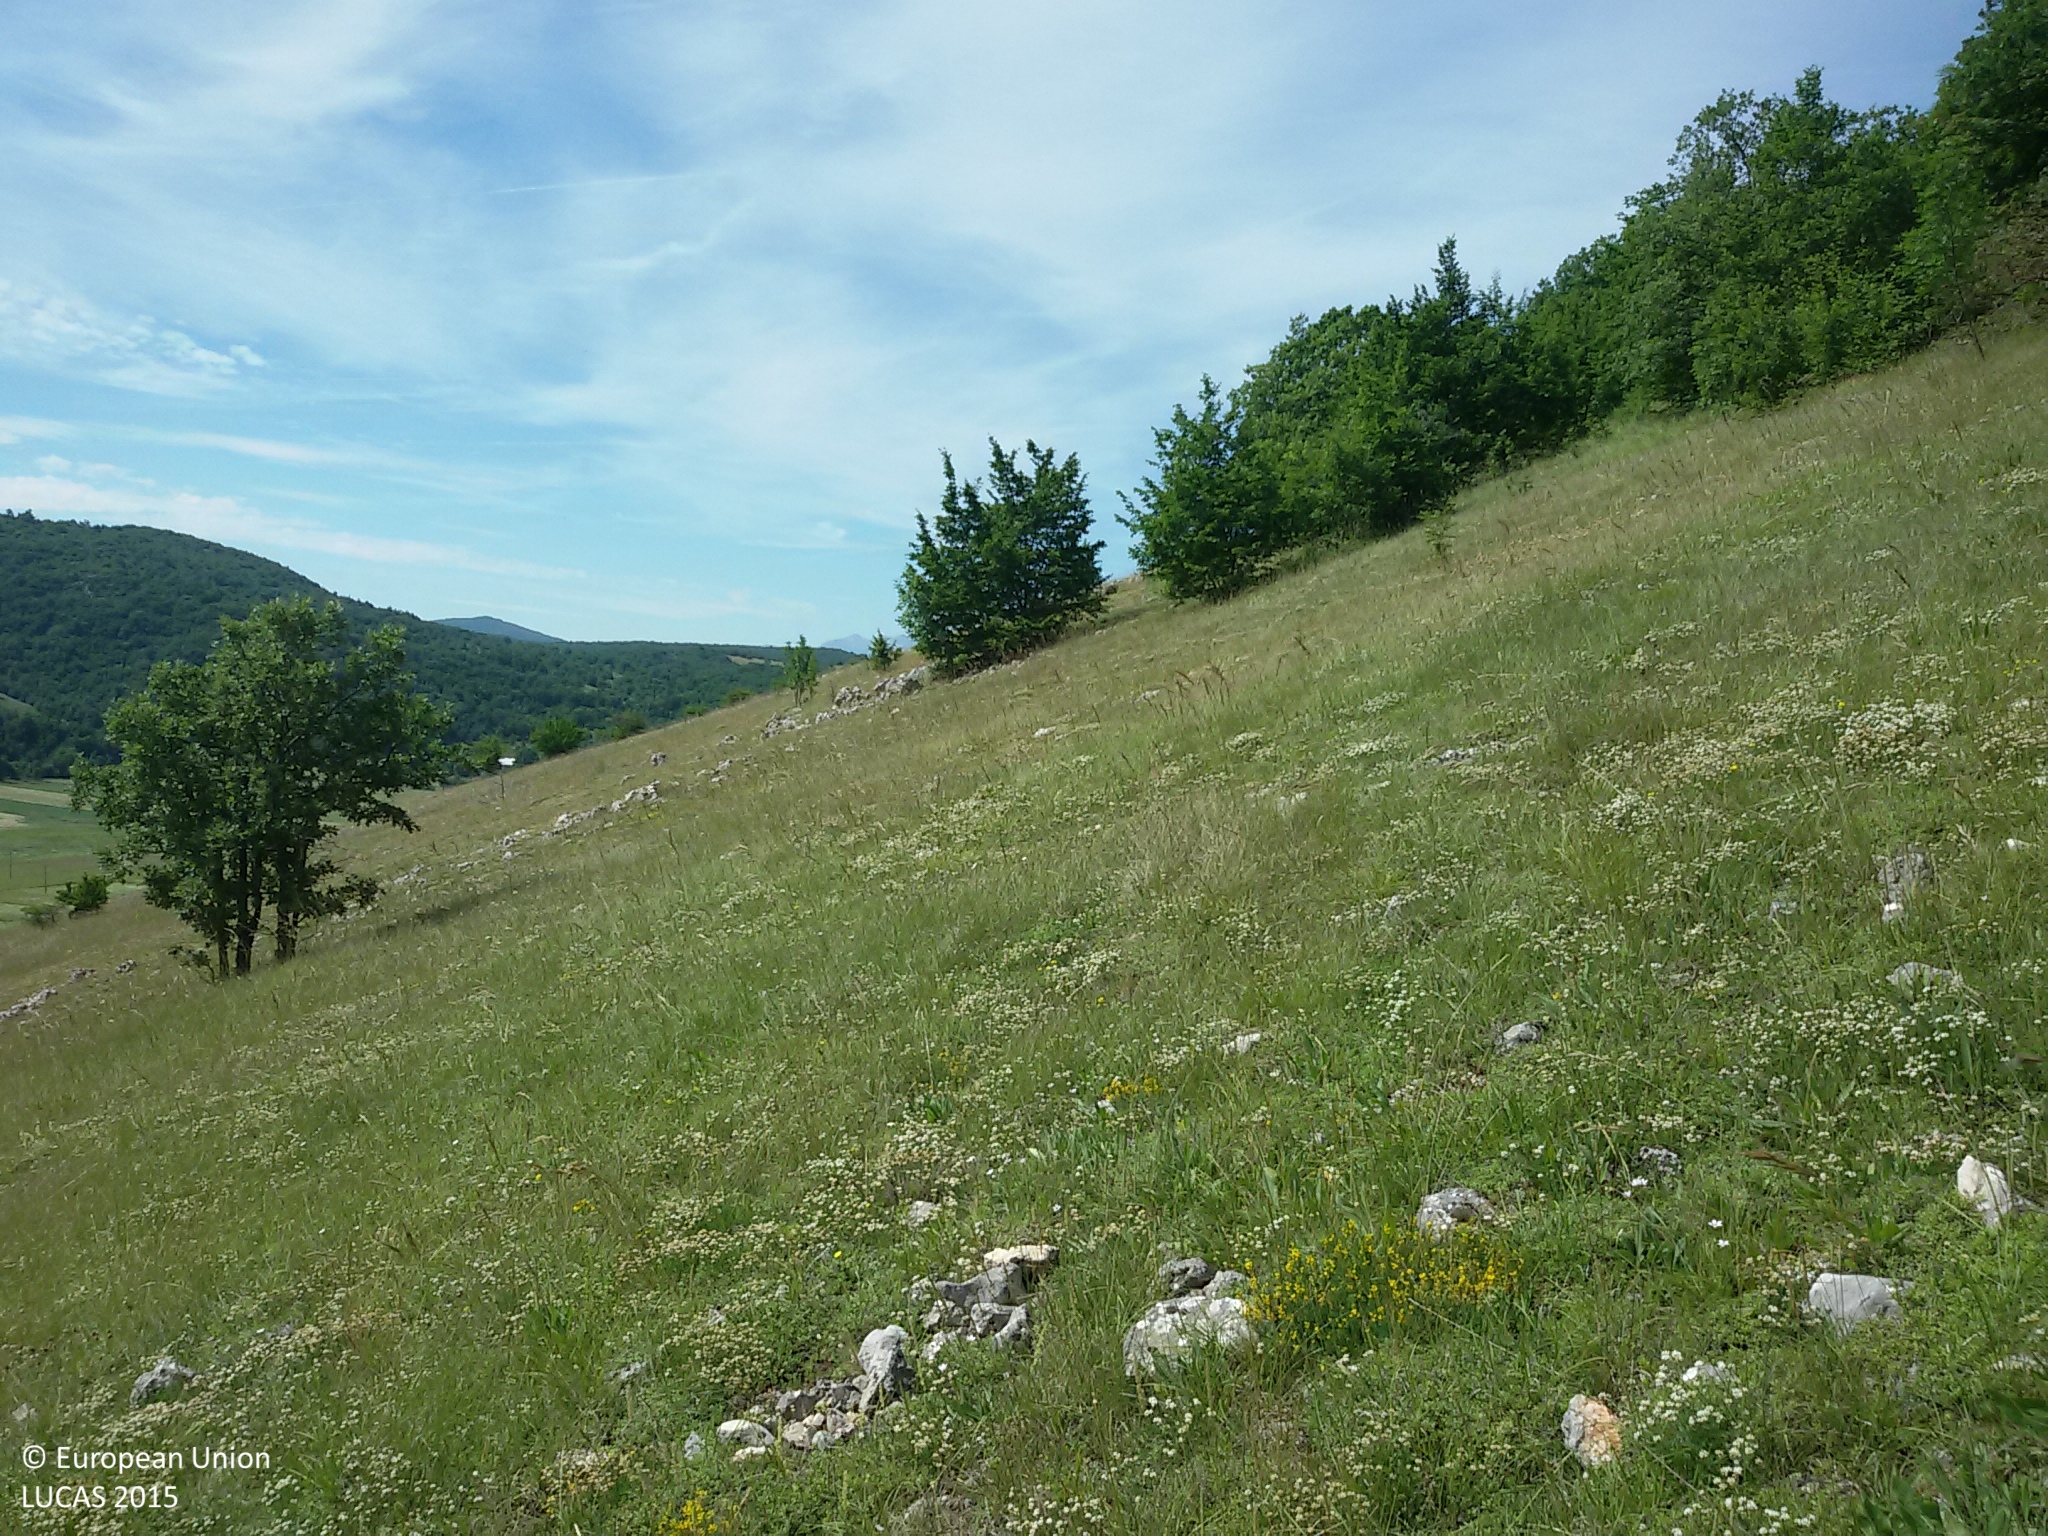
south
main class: Woodland
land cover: Broadleaved woodland
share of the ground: 10 - 25 %
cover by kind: herbaceous plants 55 %, broadleaved forest trees 15 %, unconsolidated bare surface 15 %, shrubs 10 %, consolidated bare surface 5 %
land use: Semi-natural and natural areas not in use
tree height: < 5 m
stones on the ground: < 10 %
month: June
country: HR
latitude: 44.5776
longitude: 15.6230
